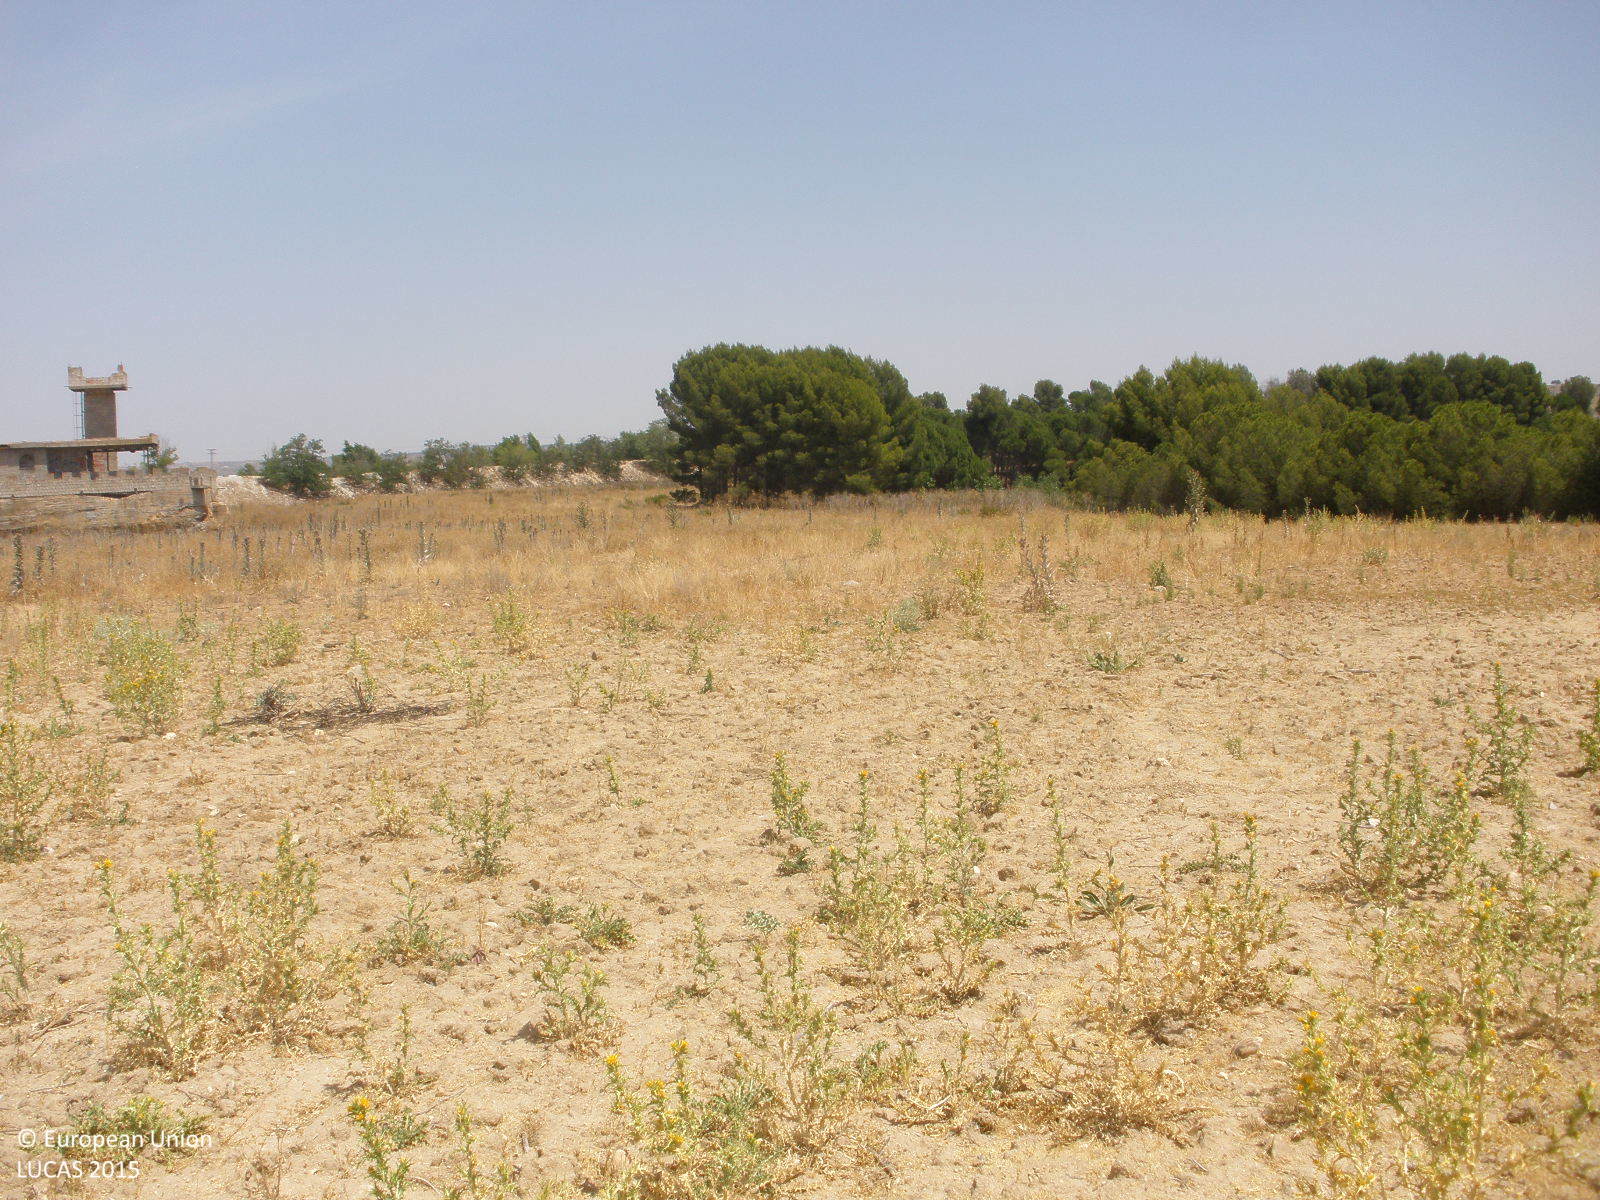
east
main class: Grassland
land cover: Spontaneously vegetated surfaces
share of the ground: 25 - 50 %
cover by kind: unconsolidated bare surface 70 %, herbaceous plants 30 %
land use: Semi-natural and natural areas not in use
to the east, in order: Spontaneously vegetated surfaces; Pine dominated coniferous woodland; Spontaneously vegetated surfaces
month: July
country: ES
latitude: 40.2996
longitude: -3.5042
